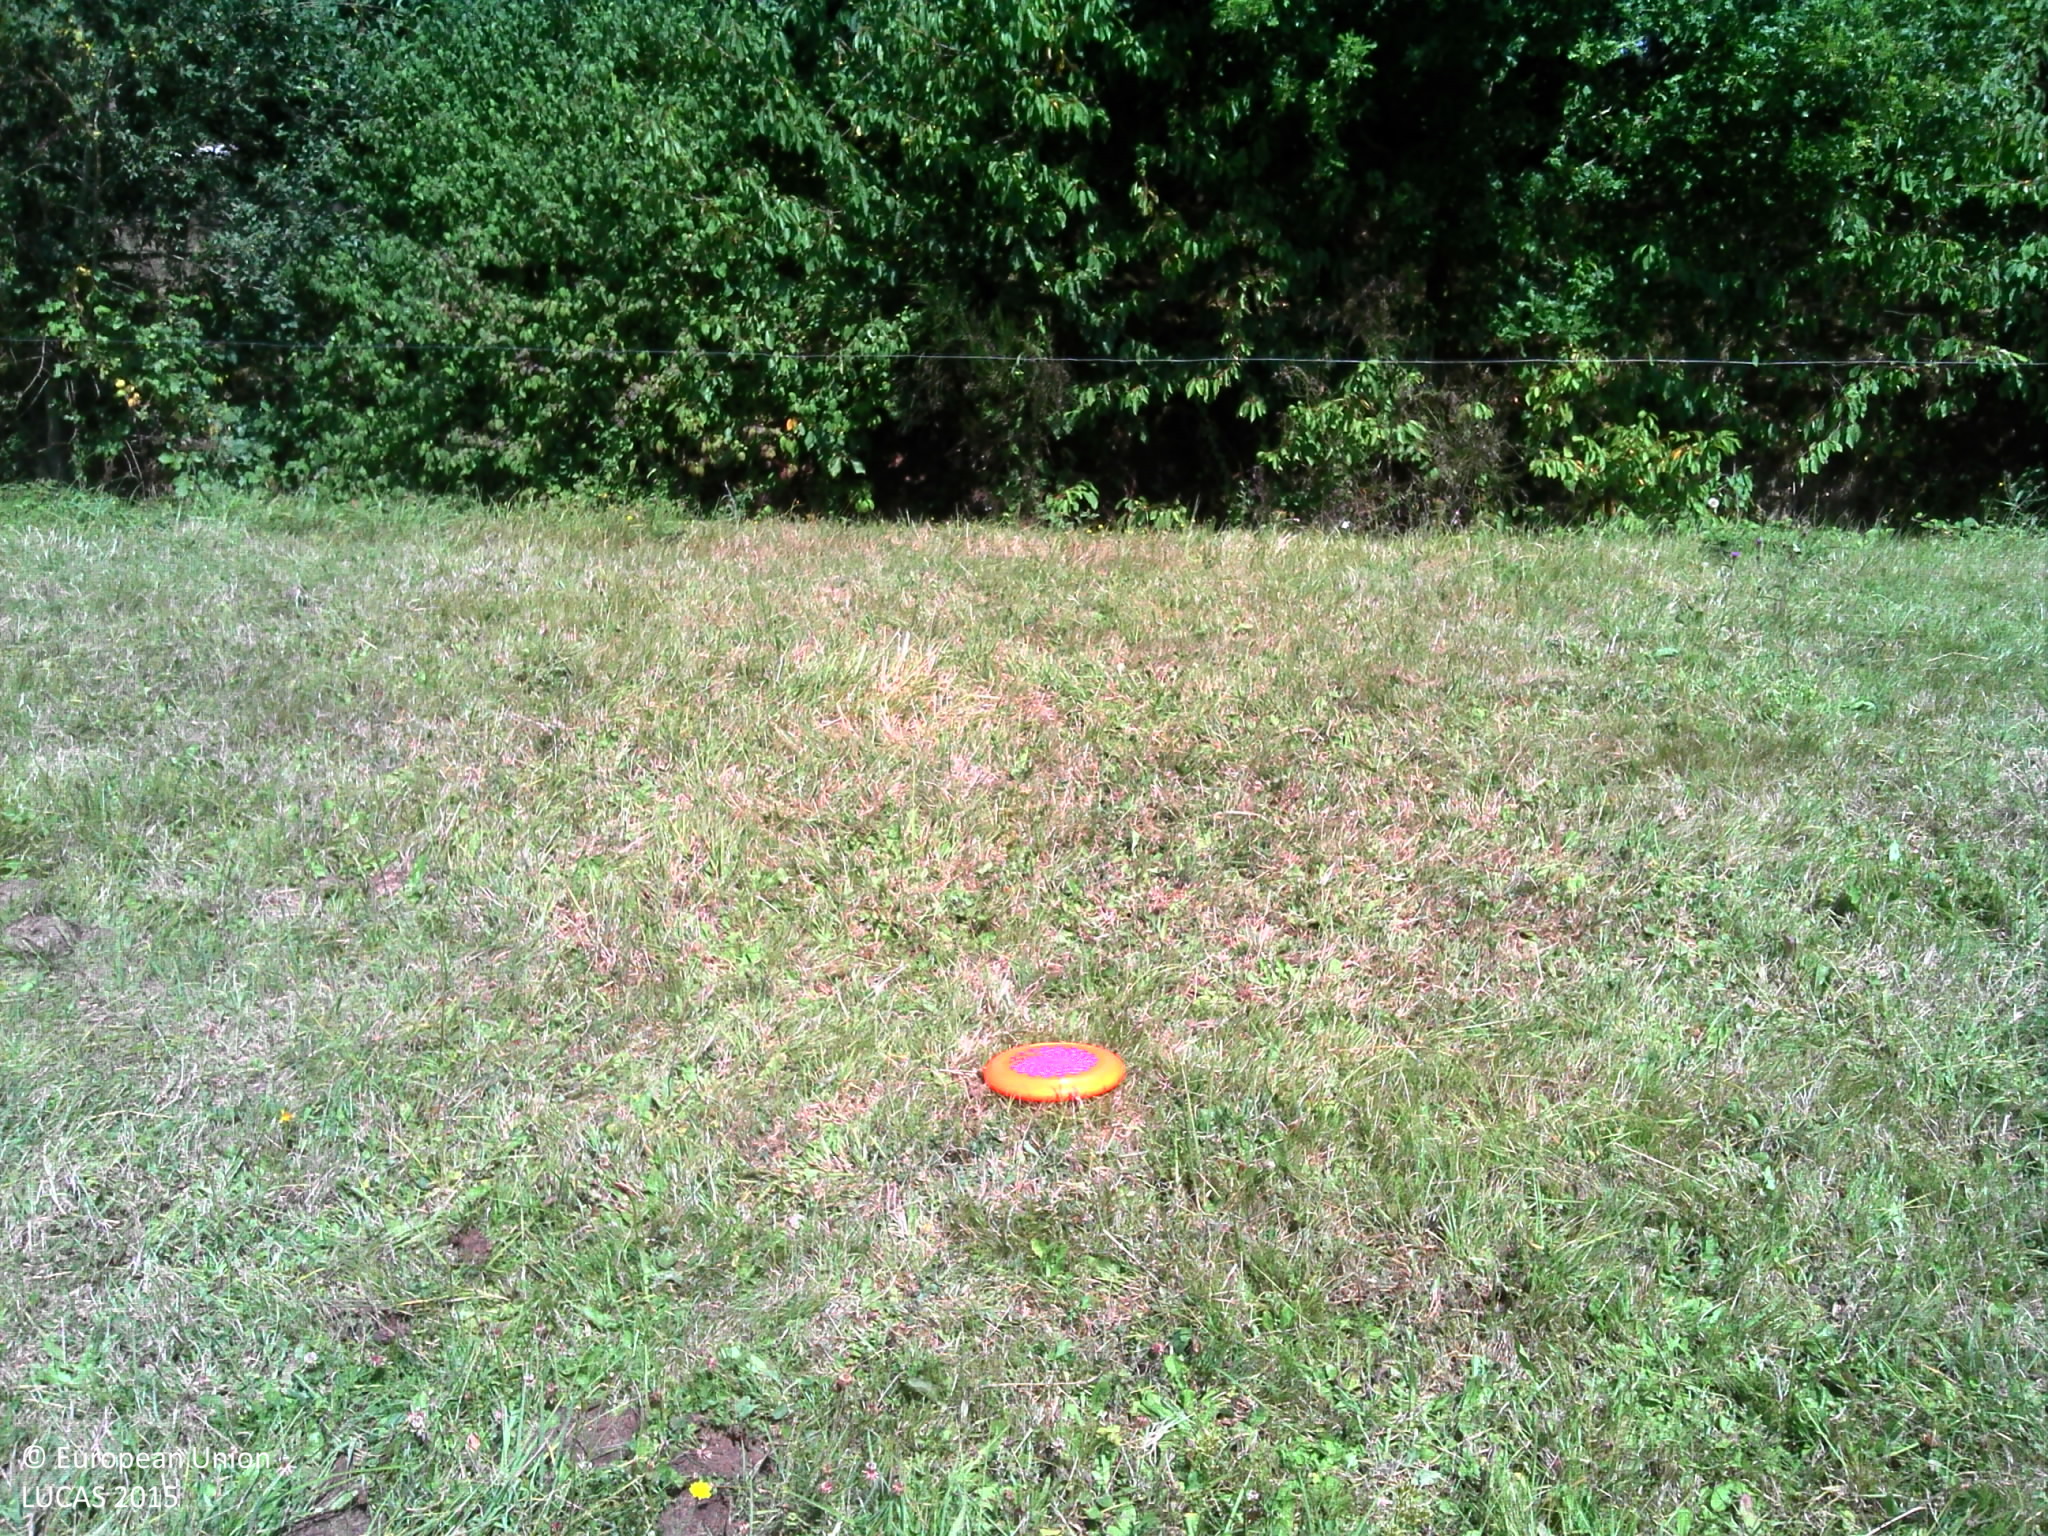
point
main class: Grassland
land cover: Grassland without tree/shrub cover
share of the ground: > 75 %
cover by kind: herbaceous plants 100 %
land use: Agriculture (excluding fallow land and kitchen gardens)
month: August
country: FR
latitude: 47.9272
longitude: -1.1625
